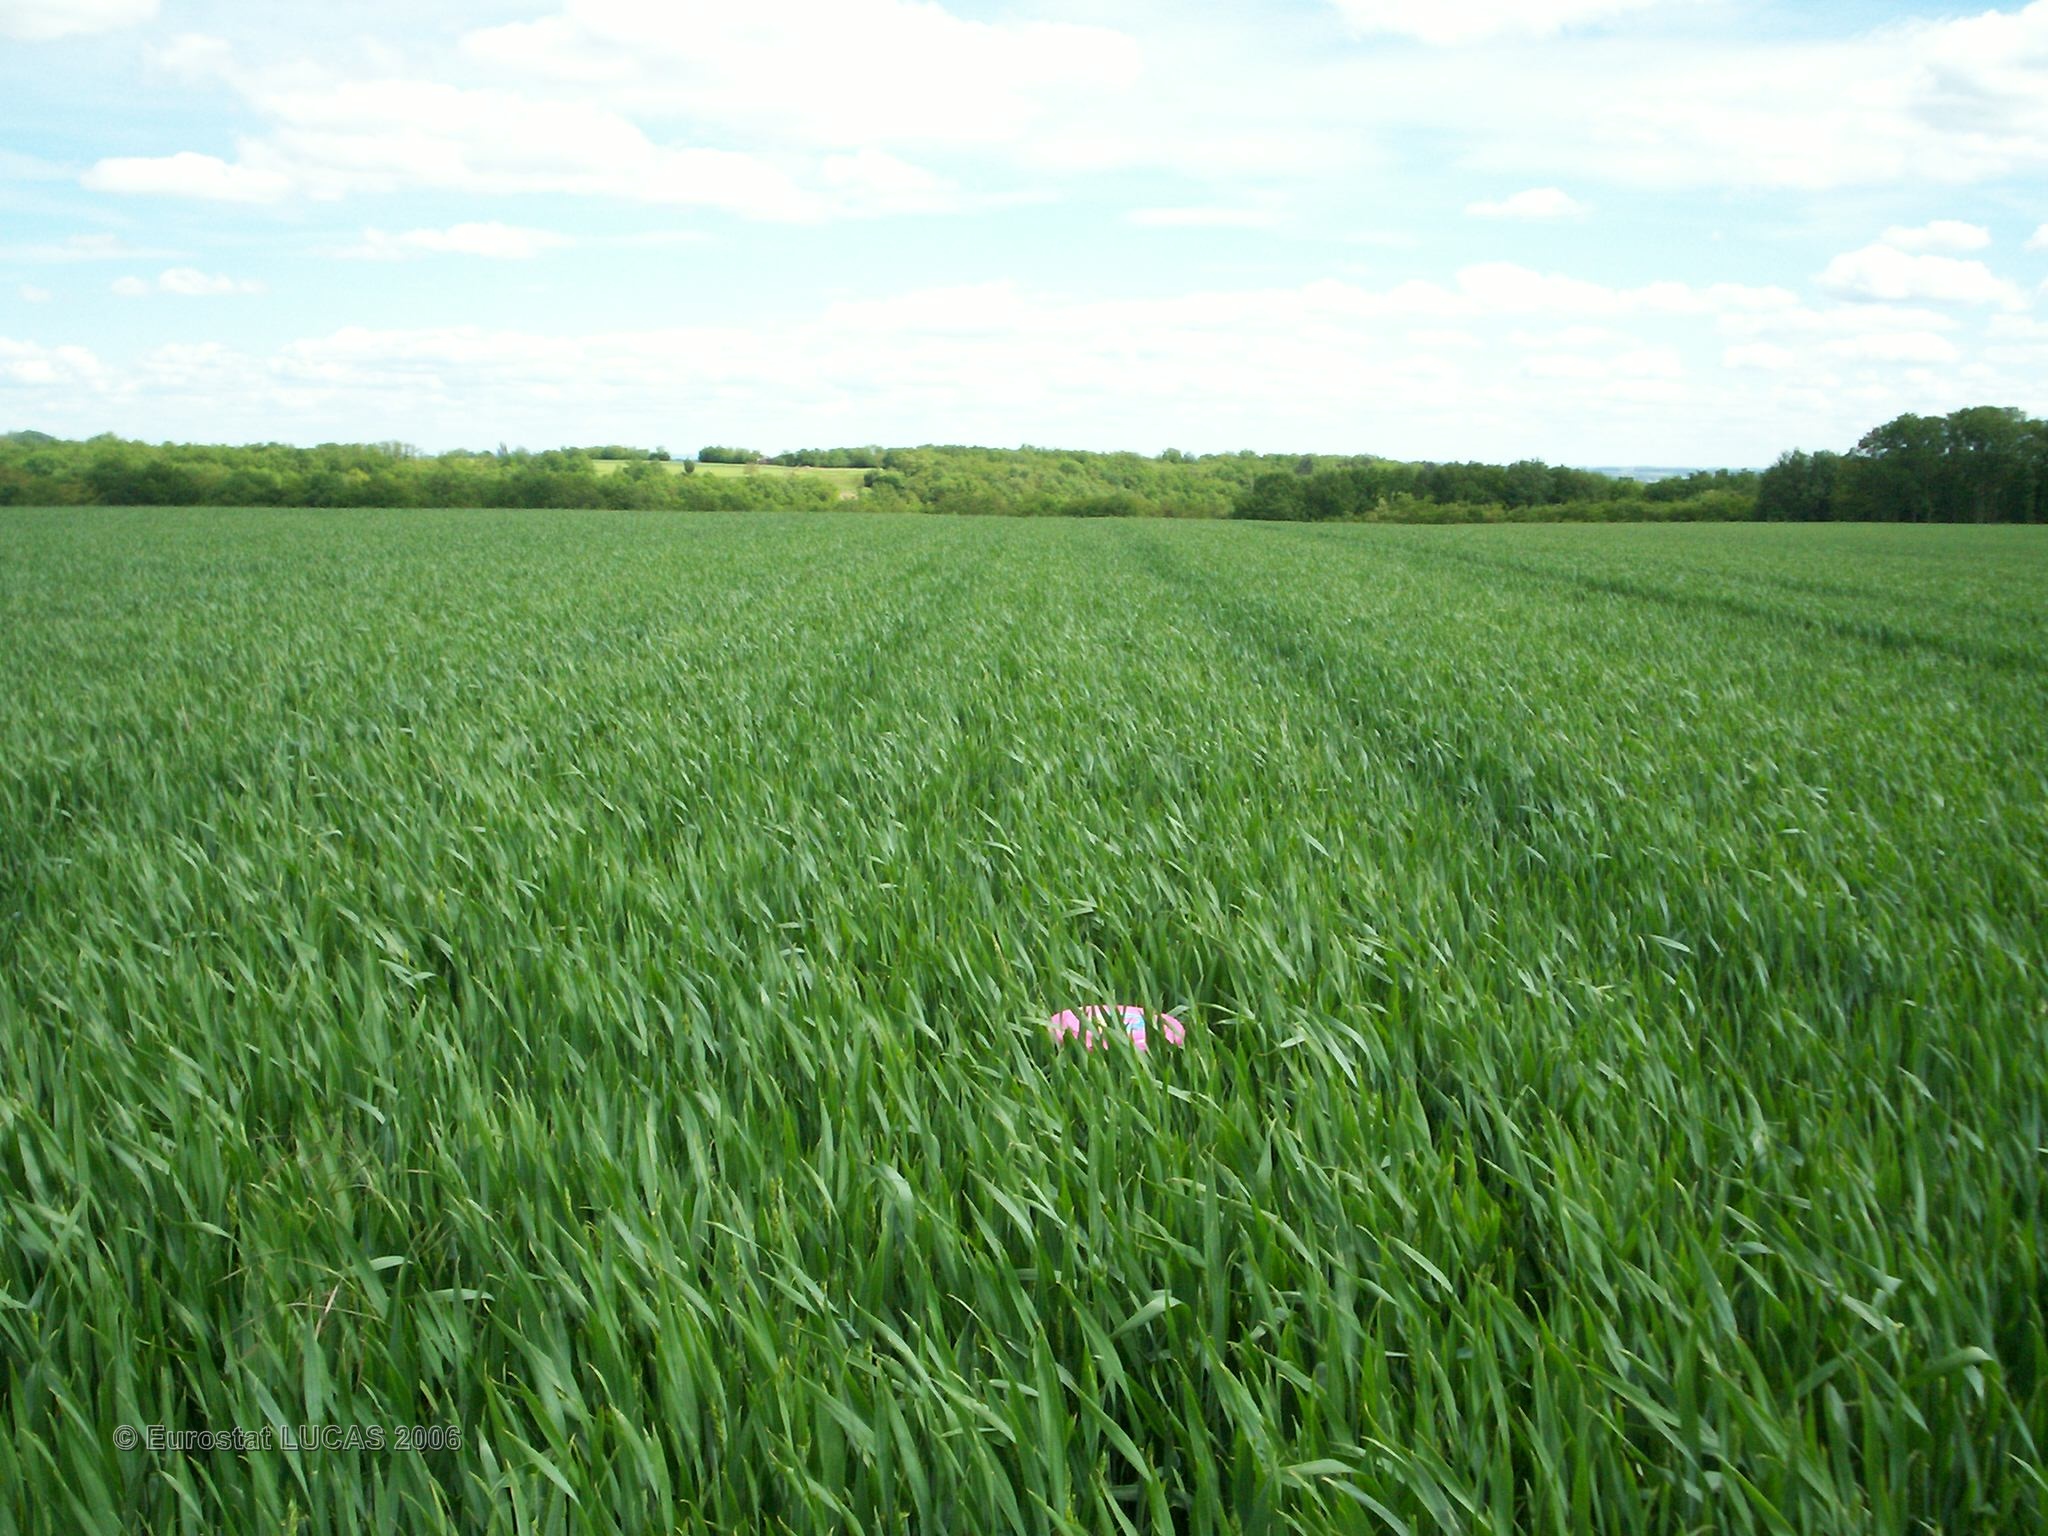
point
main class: Cropland
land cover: Common wheat
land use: Agriculture (excluding fallow land and kitchen gardens)
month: May
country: FR
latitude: 47.5594
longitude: 4.0838
